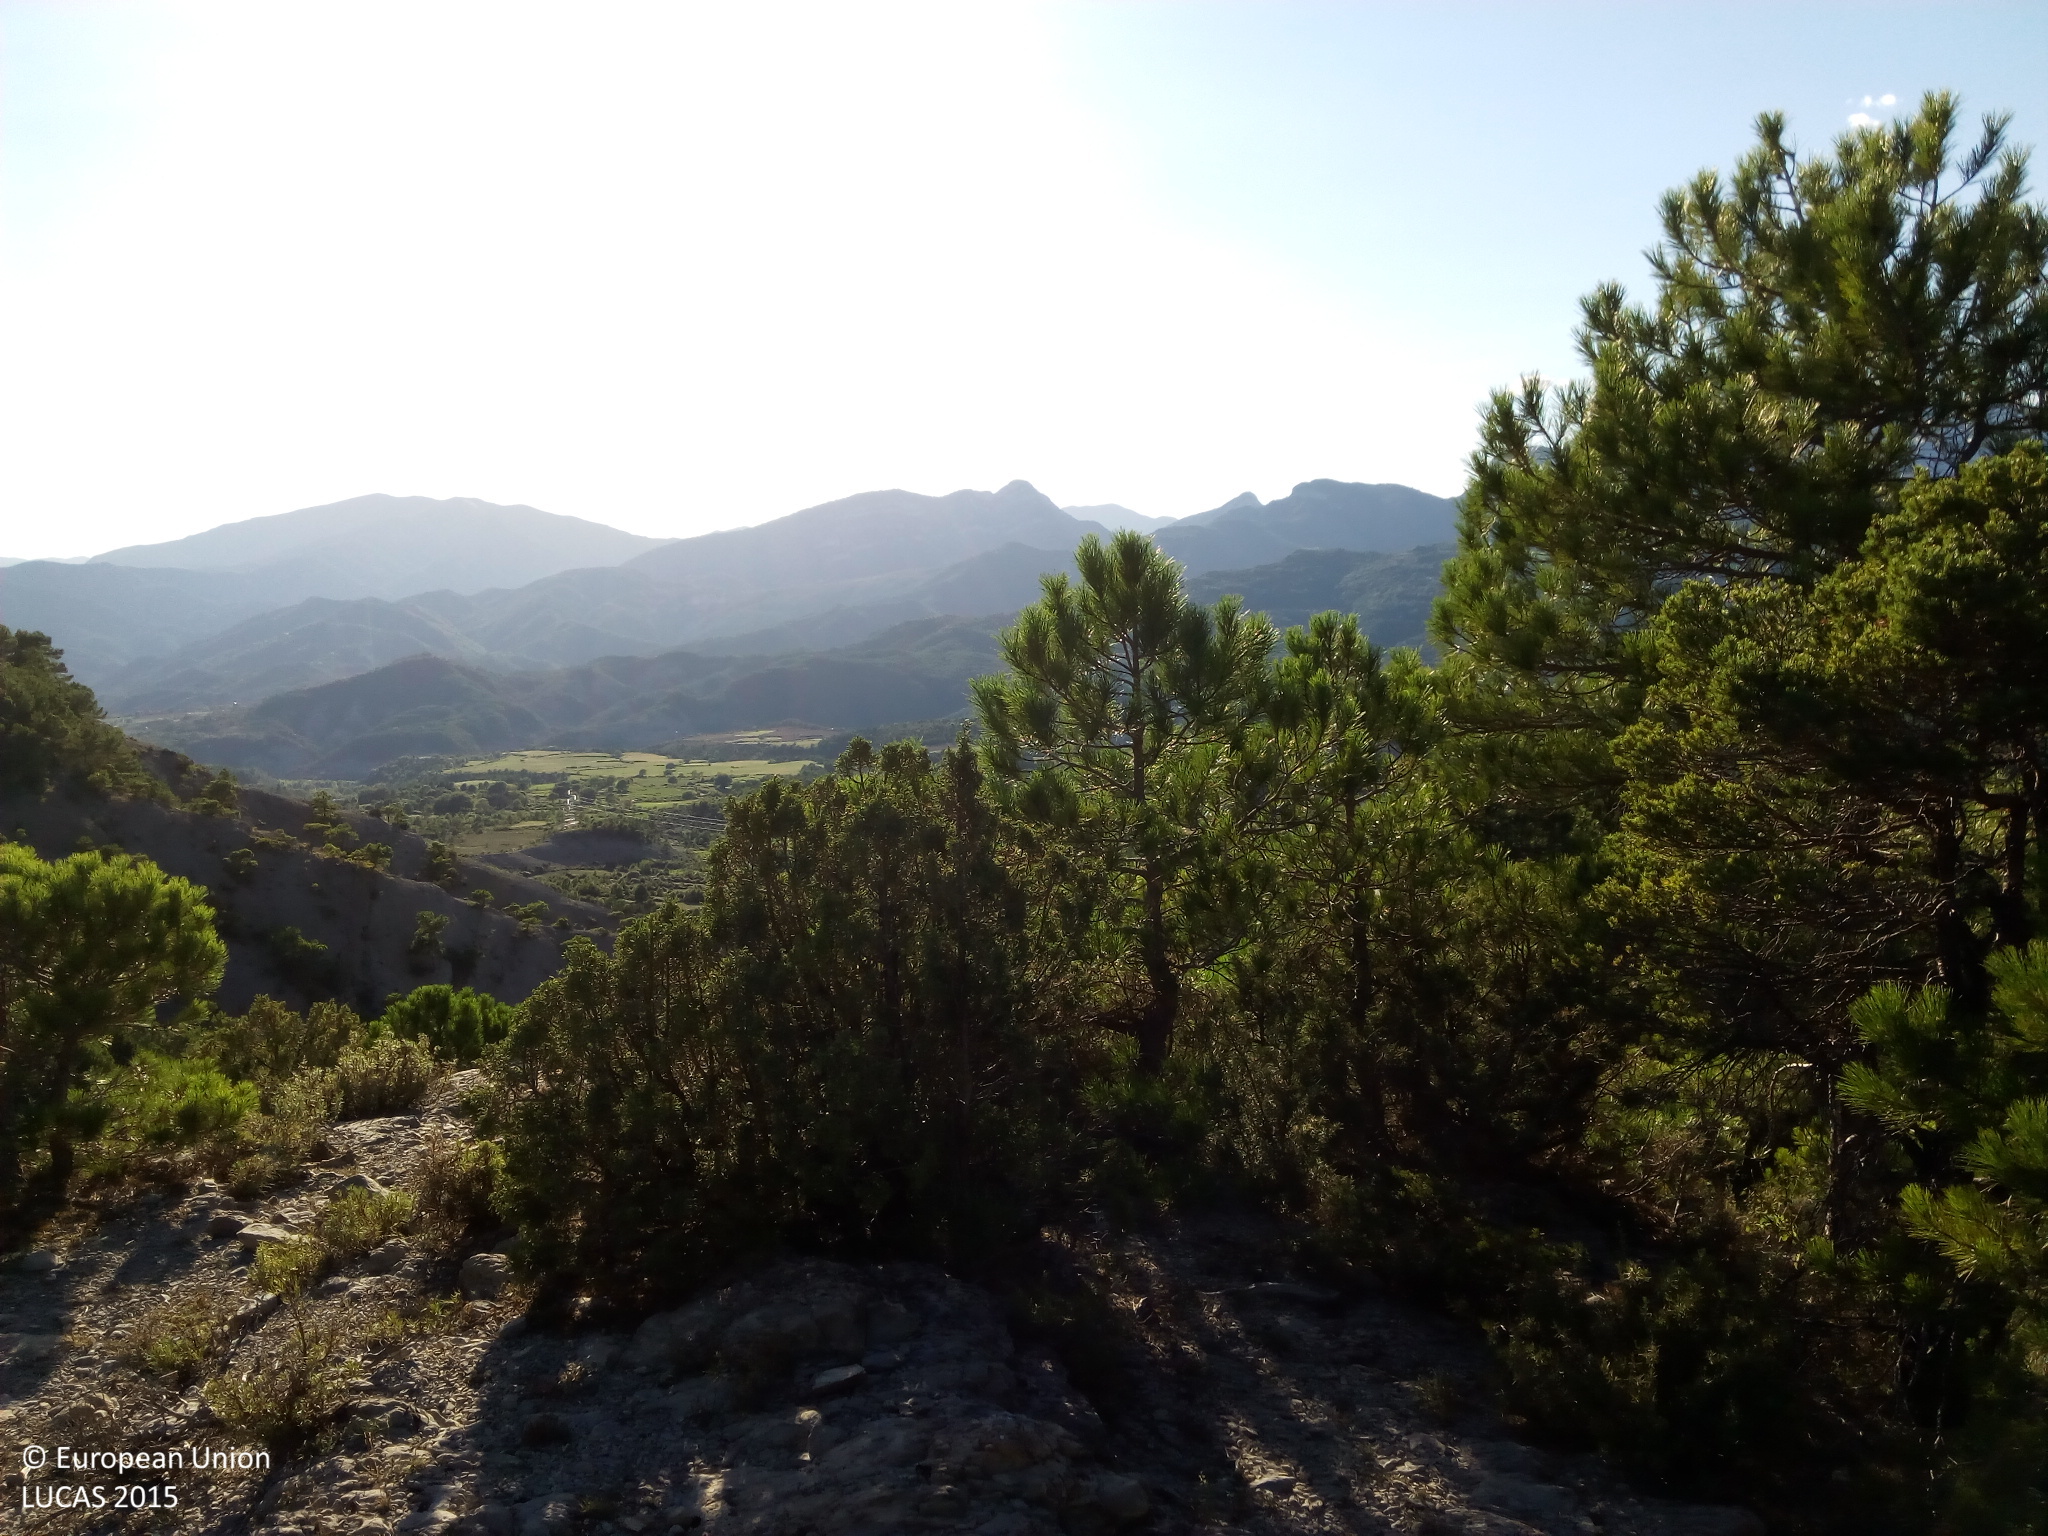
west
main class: Woodland
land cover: Pine dominated coniferous woodland
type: coniferous forest of the mediterranean region
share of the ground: > 75 %
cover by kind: coniferous forest trees 80 %, consolidated bare surface 20 %
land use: Semi-natural and natural areas not in use
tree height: > 5 m
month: August
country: ES
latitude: 42.5211
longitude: 0.1793
